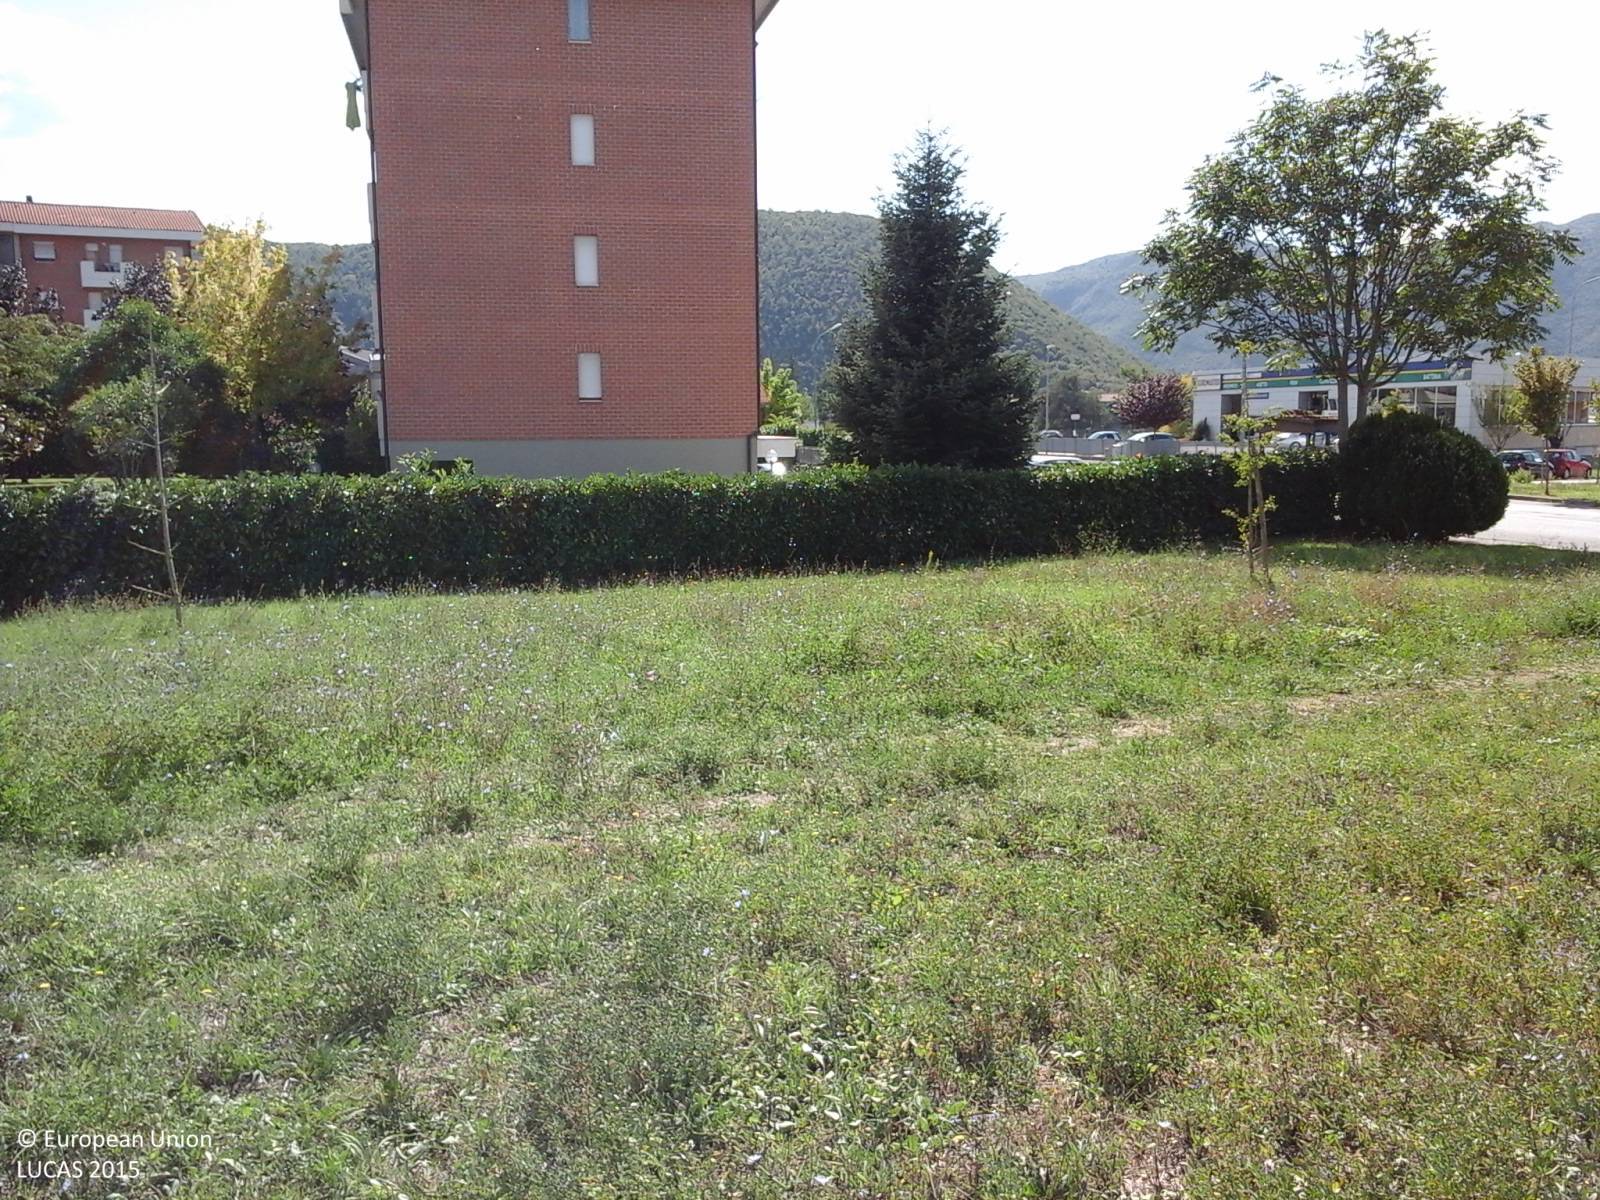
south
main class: Grassland
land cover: Grassland without tree/shrub cover
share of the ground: > 75 %
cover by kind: herbaceous plants 100 %
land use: Residential
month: October
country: IT
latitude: 42.4139
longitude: 12.8948
